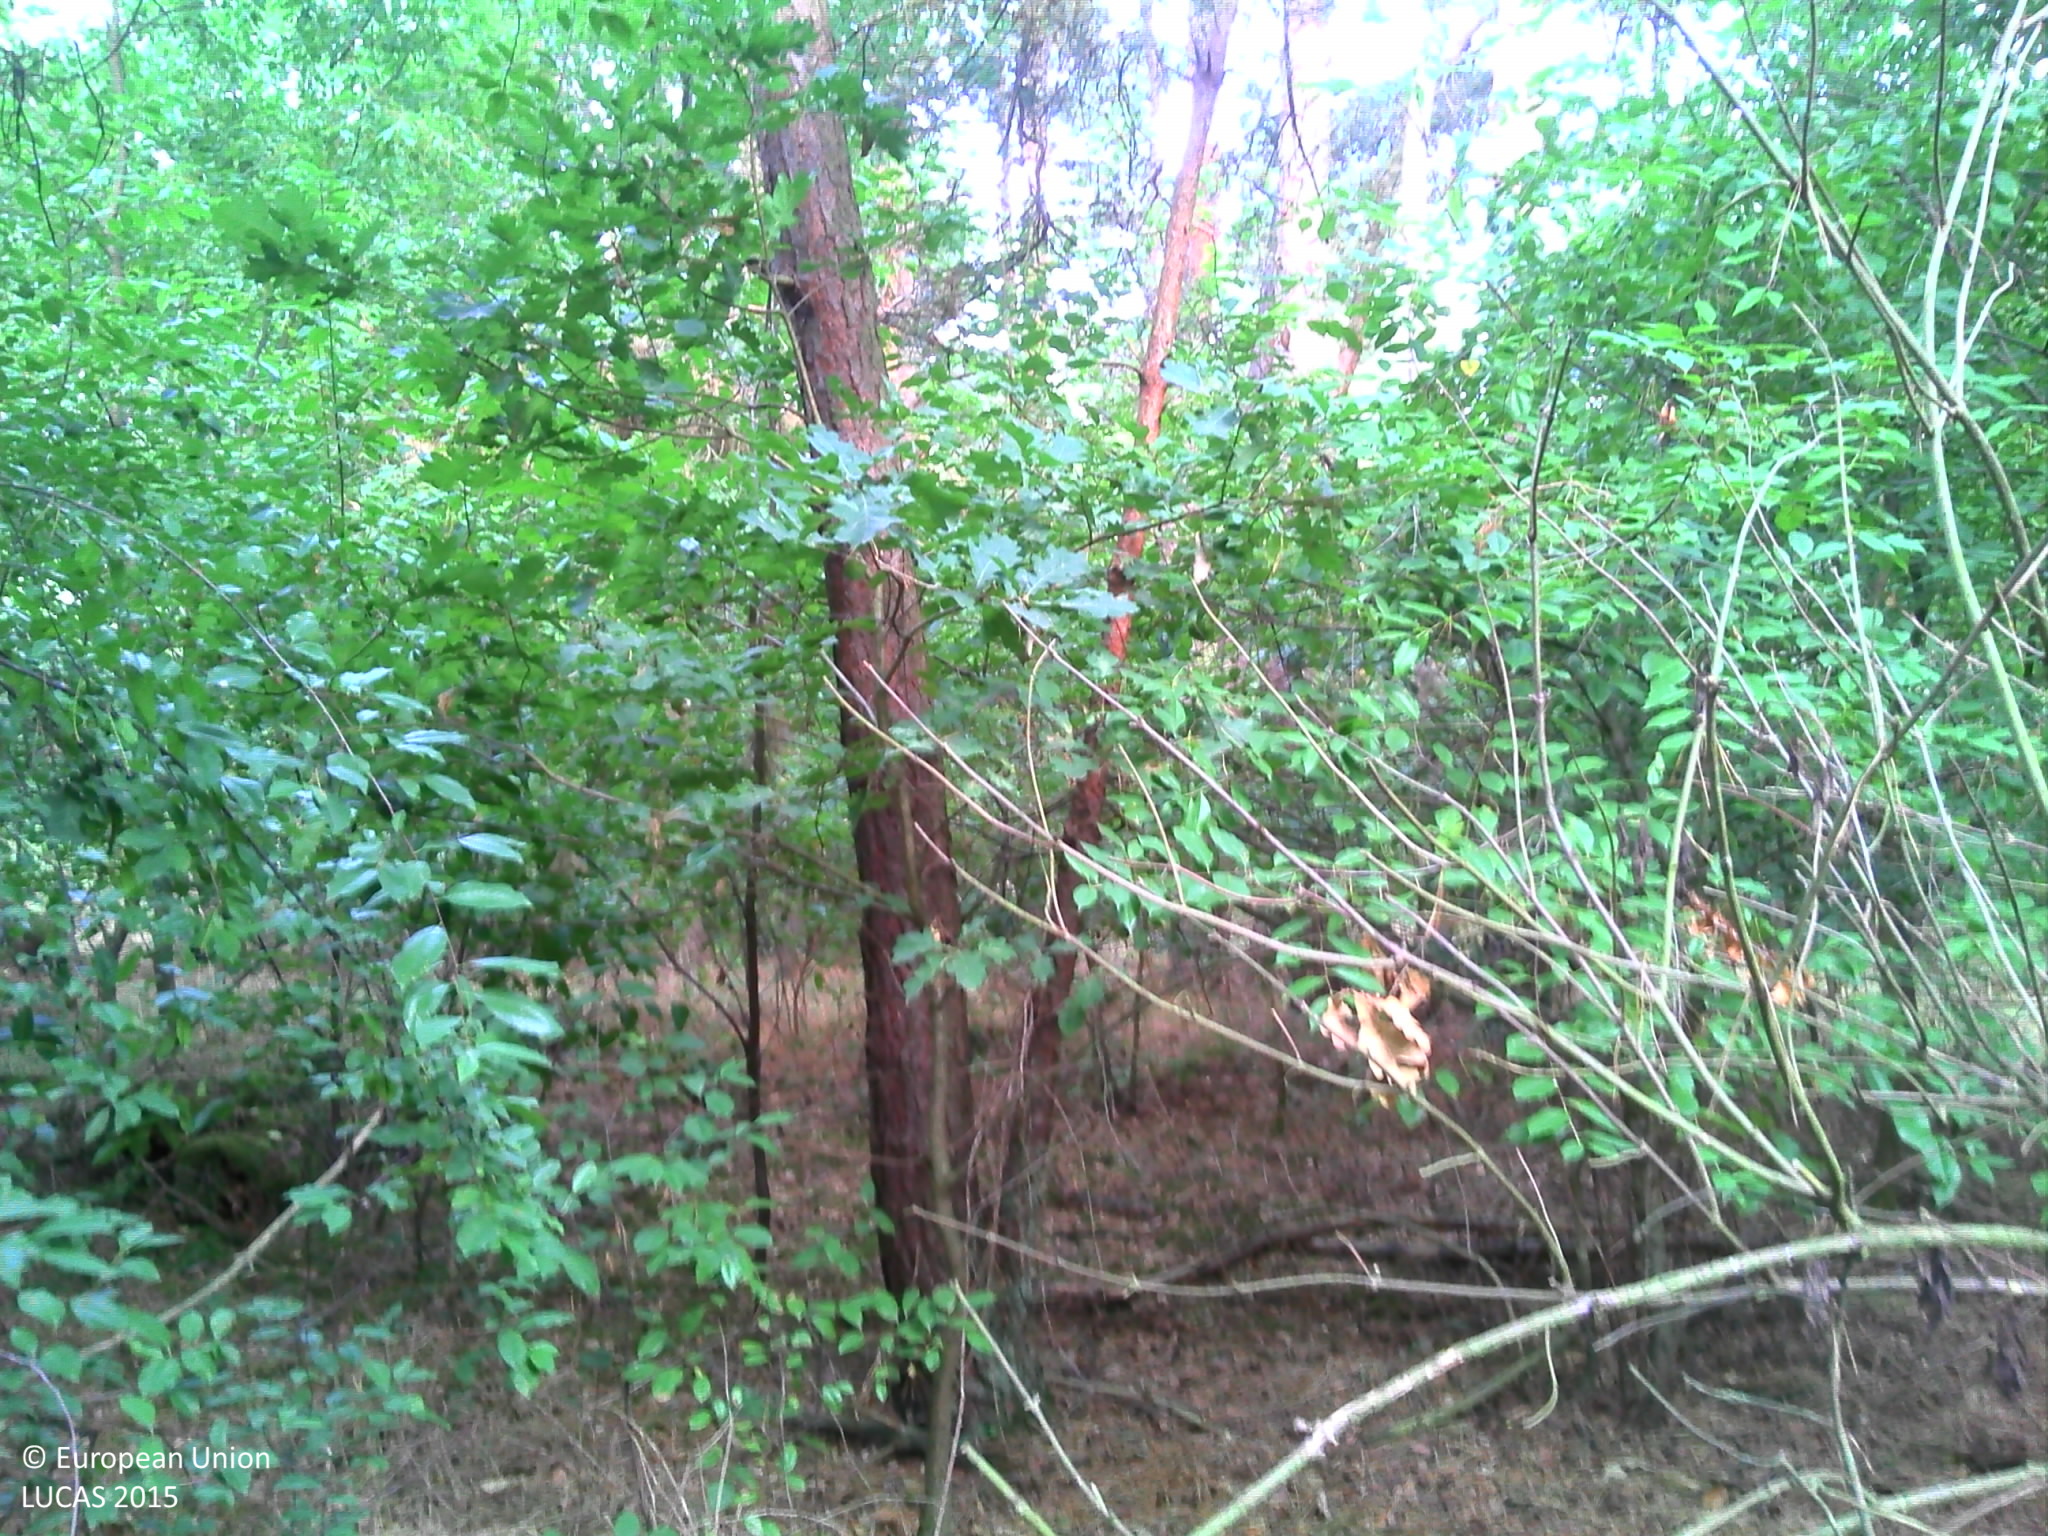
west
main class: Woodland
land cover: Pine dominated mixed woodland
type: hemiboreal forest and nemoral coniferous forest and mixed broadleaved-coniferous forest
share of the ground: > 75 %
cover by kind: broadleaved forest trees 50 %, coniferous forest trees 35 %, herbaceous plants 15 %
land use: Forestry
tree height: > 5 m
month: August
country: FR
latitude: 48.7042
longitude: 7.7315
